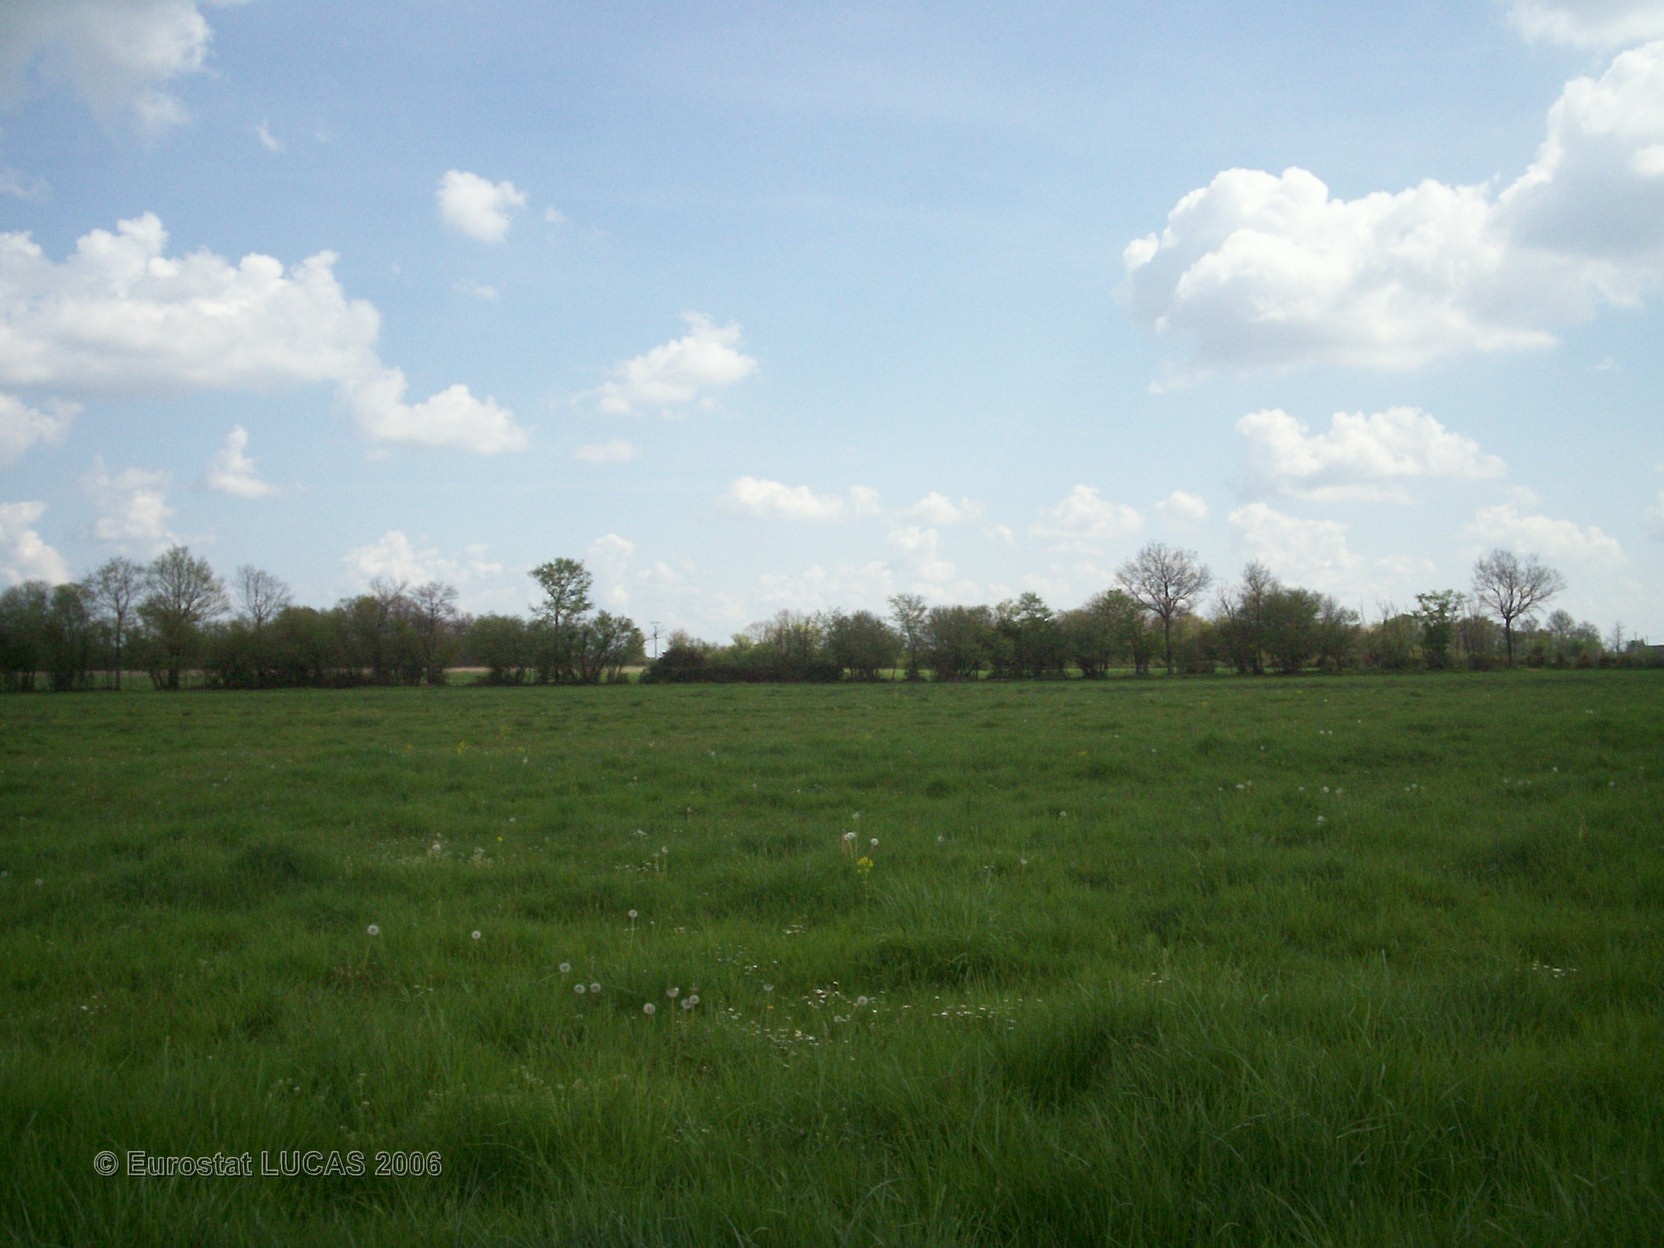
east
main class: Grassland
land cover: Grassland with sparse tree/shrub cover
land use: Agriculture (excluding fallow land and kitchen gardens)
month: April
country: FR
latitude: 46.3633
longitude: 0.5079
